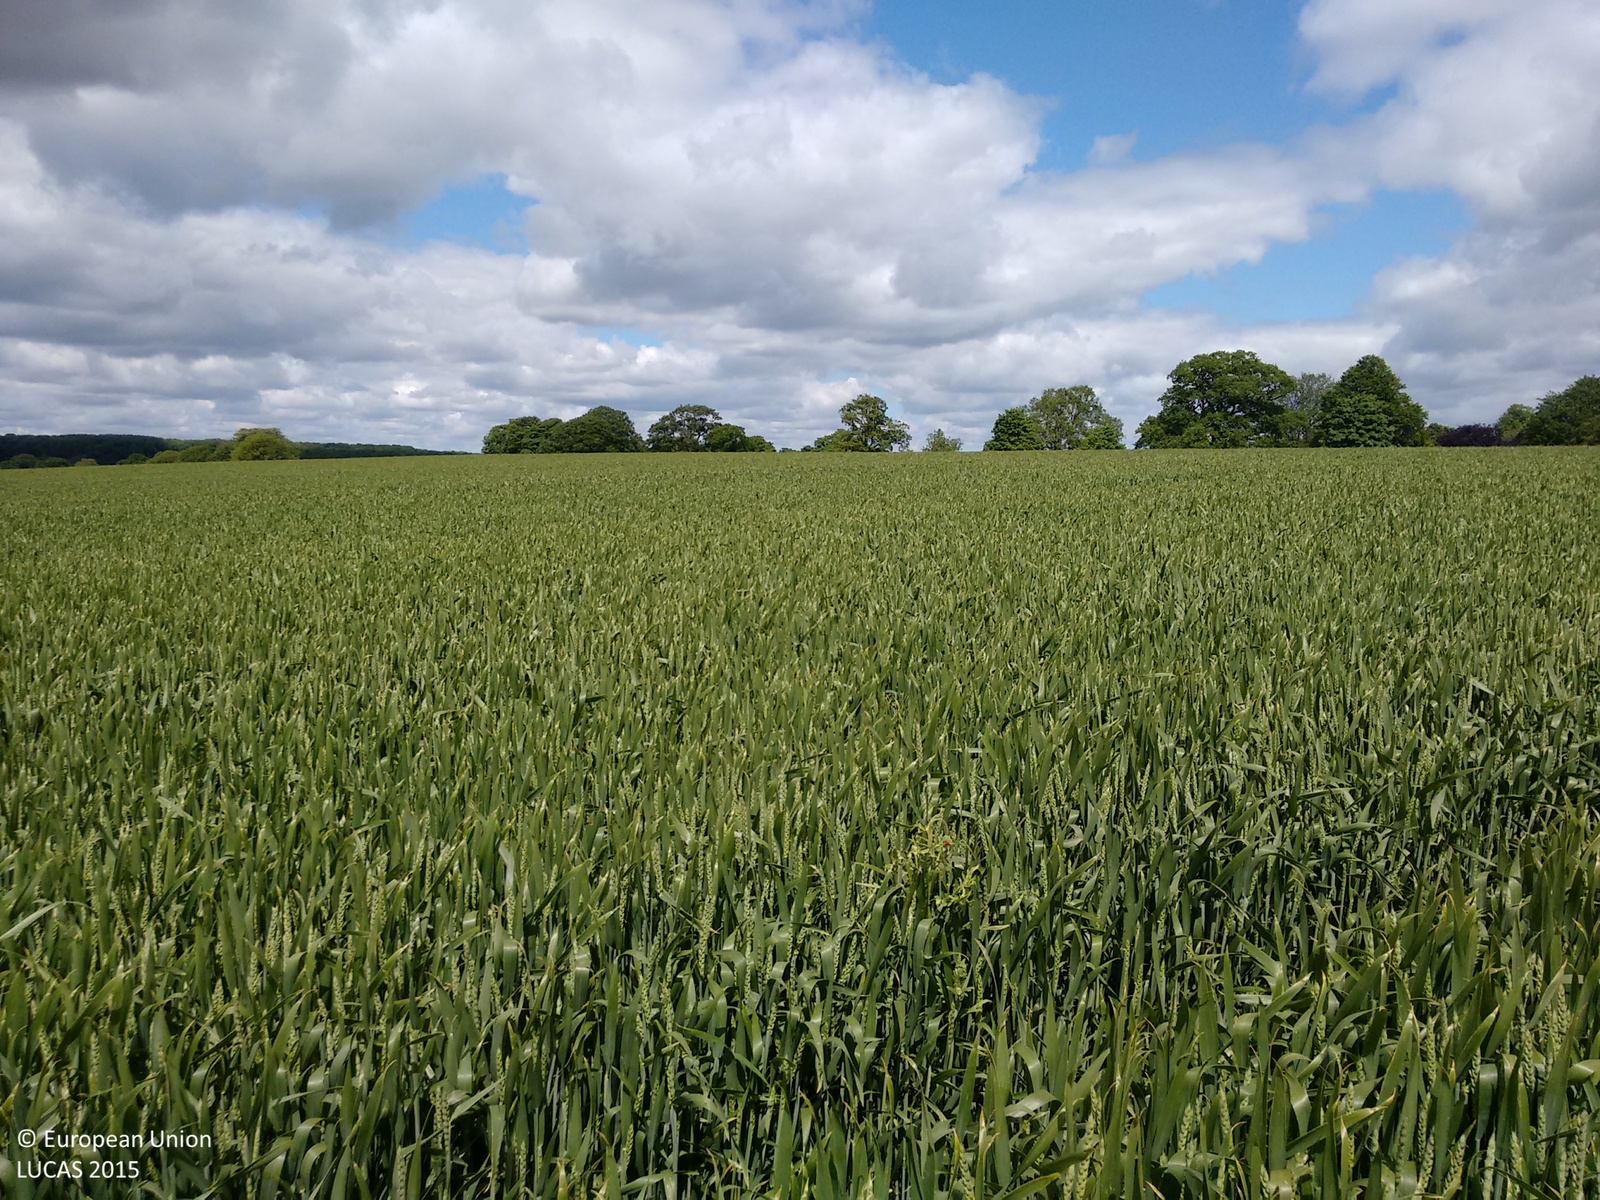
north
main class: Cropland
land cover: Common wheat
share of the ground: > 75 %
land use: Agriculture (excluding fallow land and kitchen gardens)
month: June
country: GB
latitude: 54.0161
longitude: -0.8922
